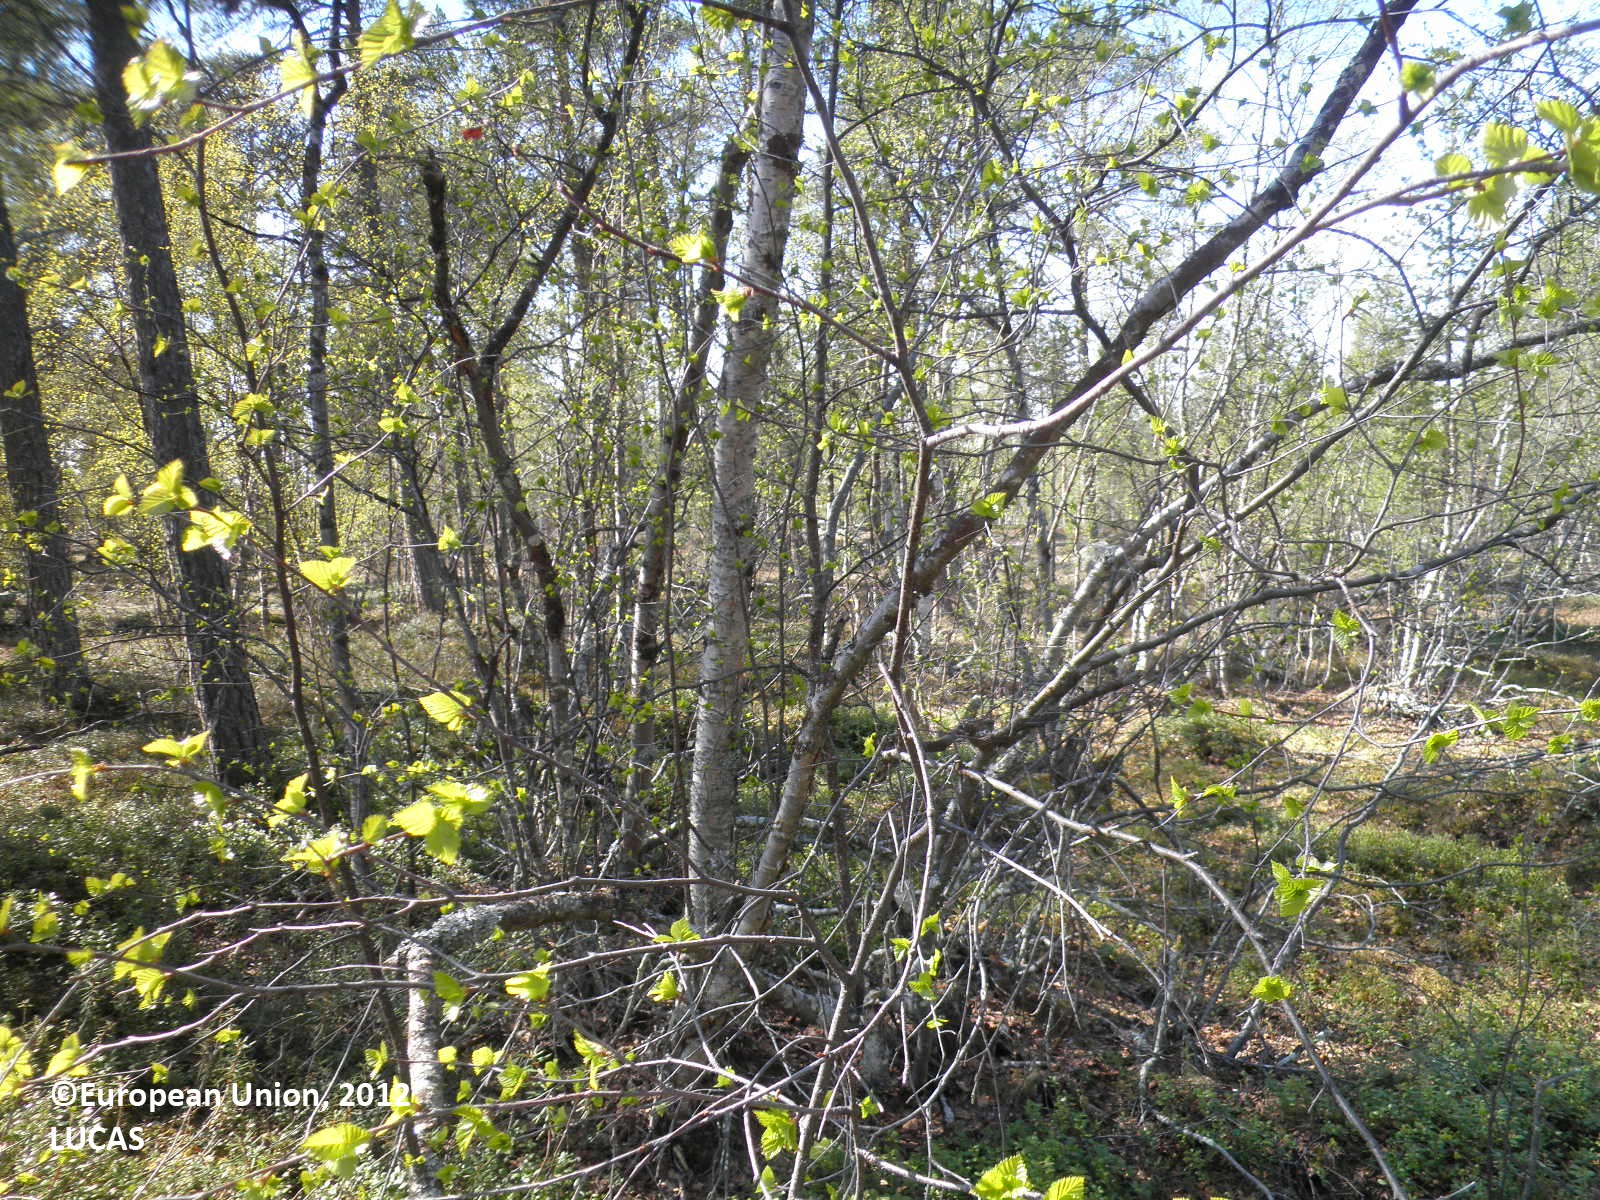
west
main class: Woodland
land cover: Pine dominated mixed woodland
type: boreal forest
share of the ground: > 75 %
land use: Forestry
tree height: > 5 m
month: June
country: FI
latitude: 69.4923
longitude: 28.5849
